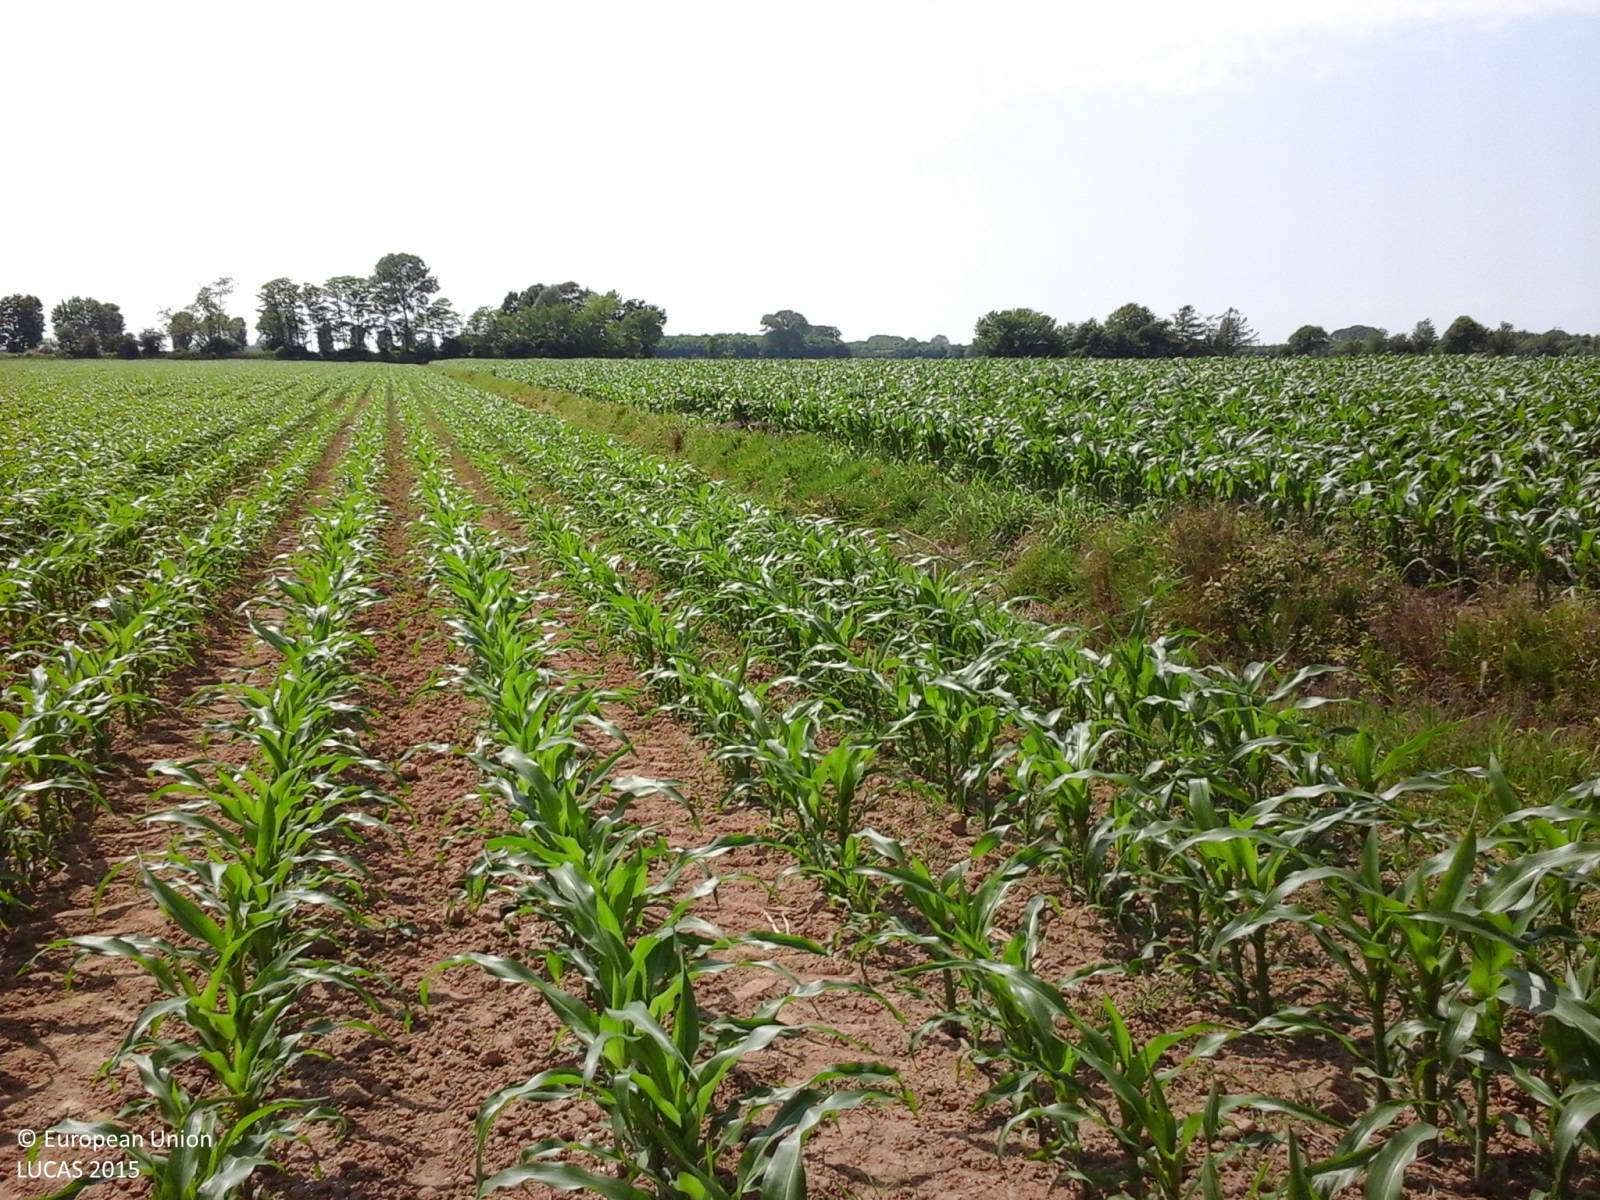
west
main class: Cropland
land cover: Maize
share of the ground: 50 - 75 %
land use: Agriculture (excluding fallow land and kitchen gardens)
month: May
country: IT
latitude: 45.7390
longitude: 13.3760
